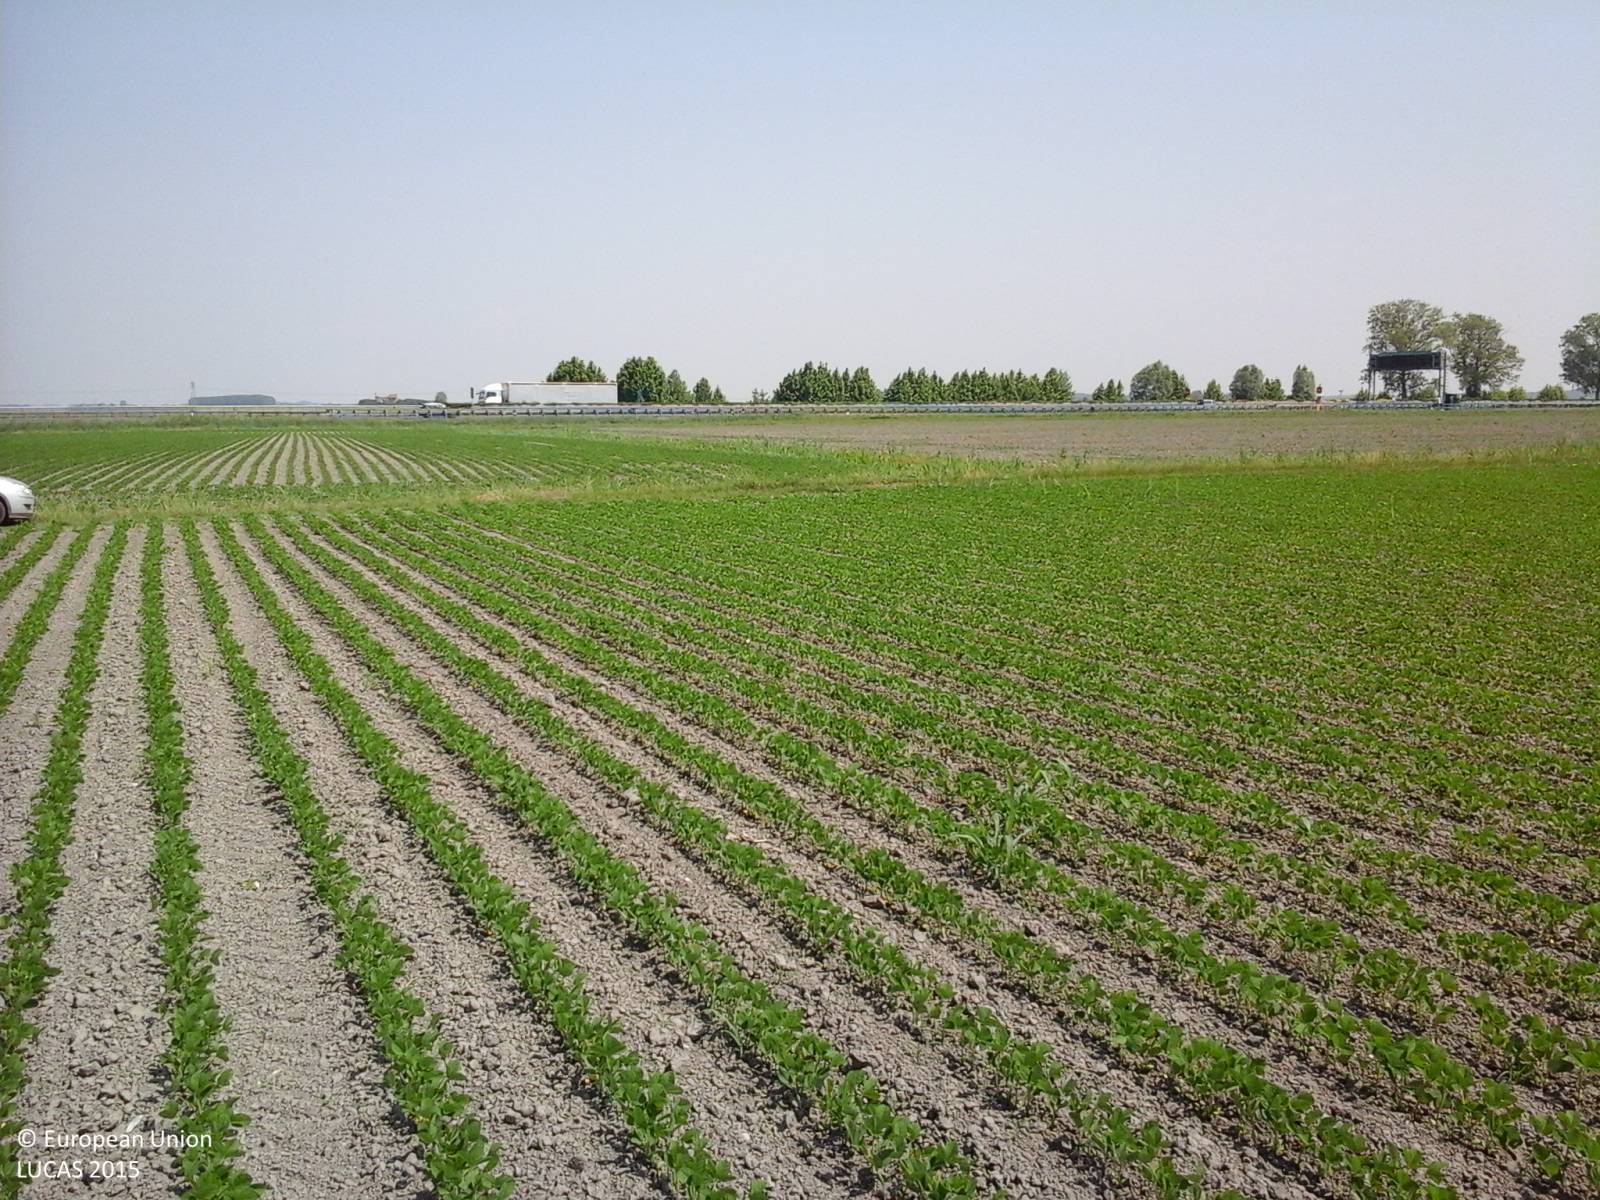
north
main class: Cropland
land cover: Soya
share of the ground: 10 - 25 %
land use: Agriculture (excluding fallow land and kitchen gardens)
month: June
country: IT
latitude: 45.8060
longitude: 12.9429
